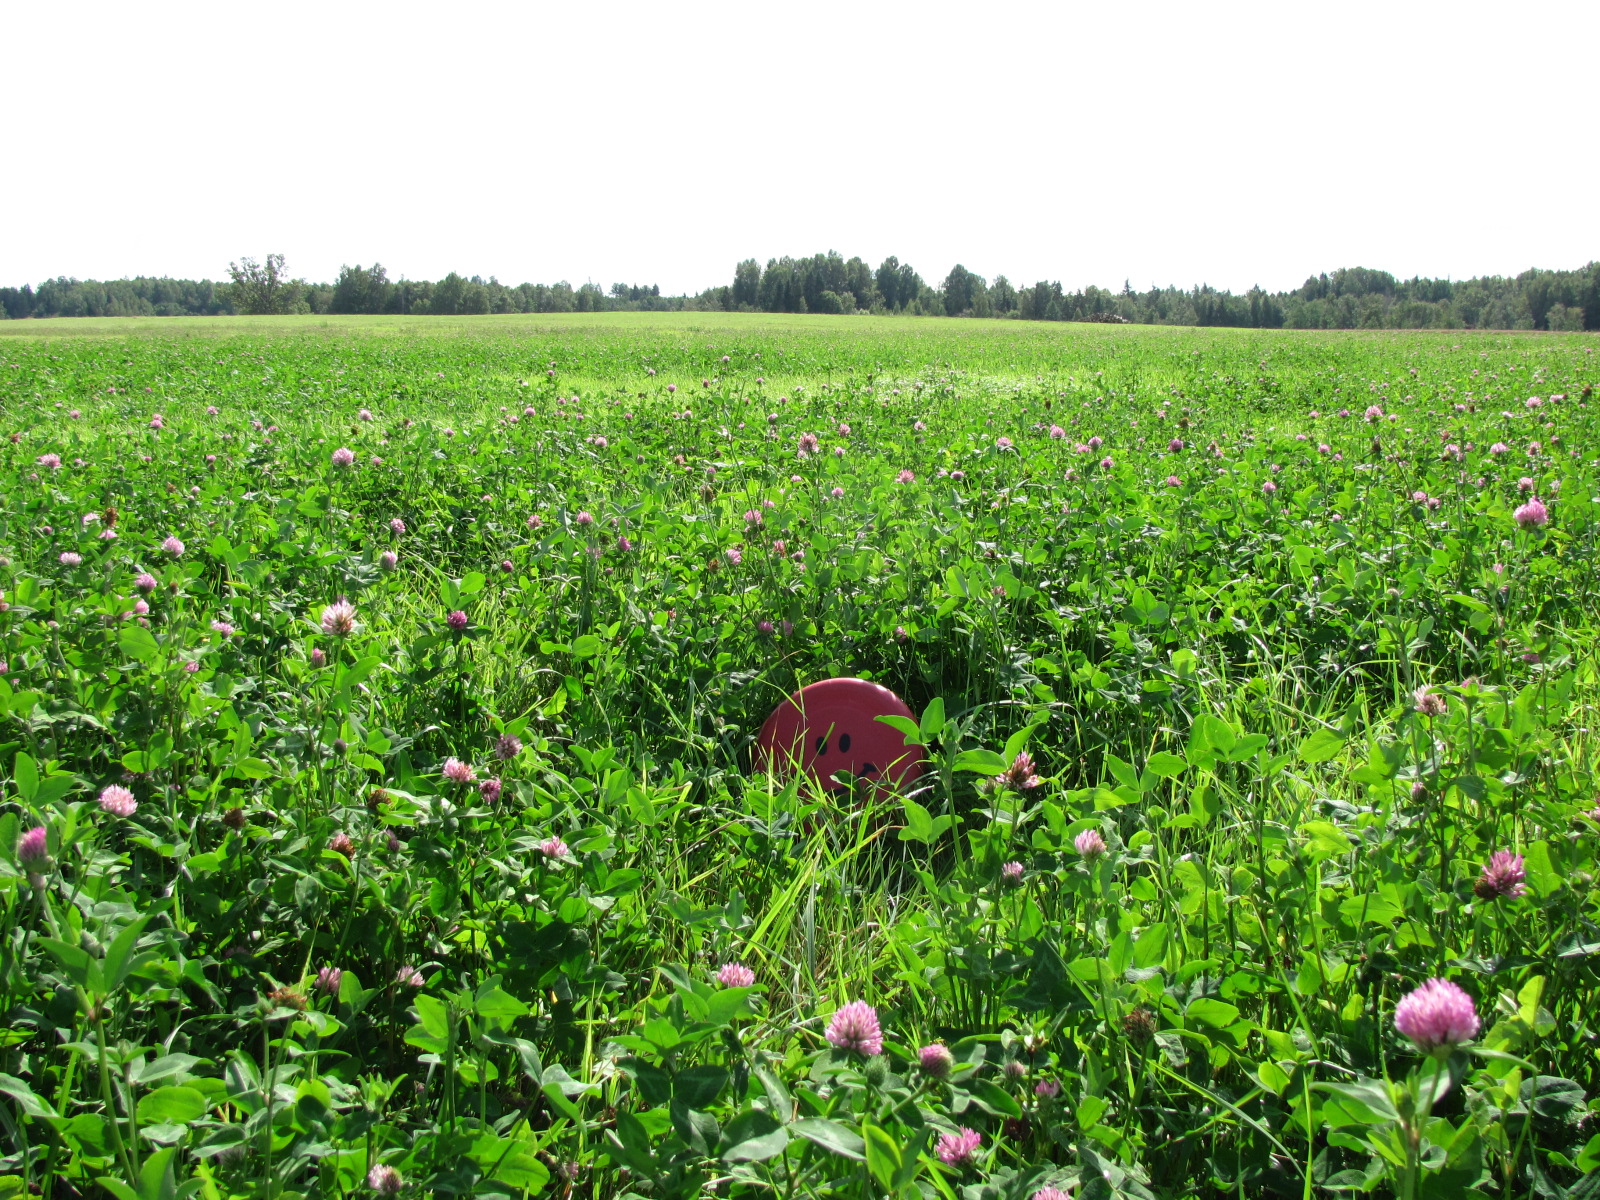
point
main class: Cropland
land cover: Clovers
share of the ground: > 75 %
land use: Agriculture (excluding fallow land and kitchen gardens)
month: August
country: LV
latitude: 56.8952
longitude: 25.2984
